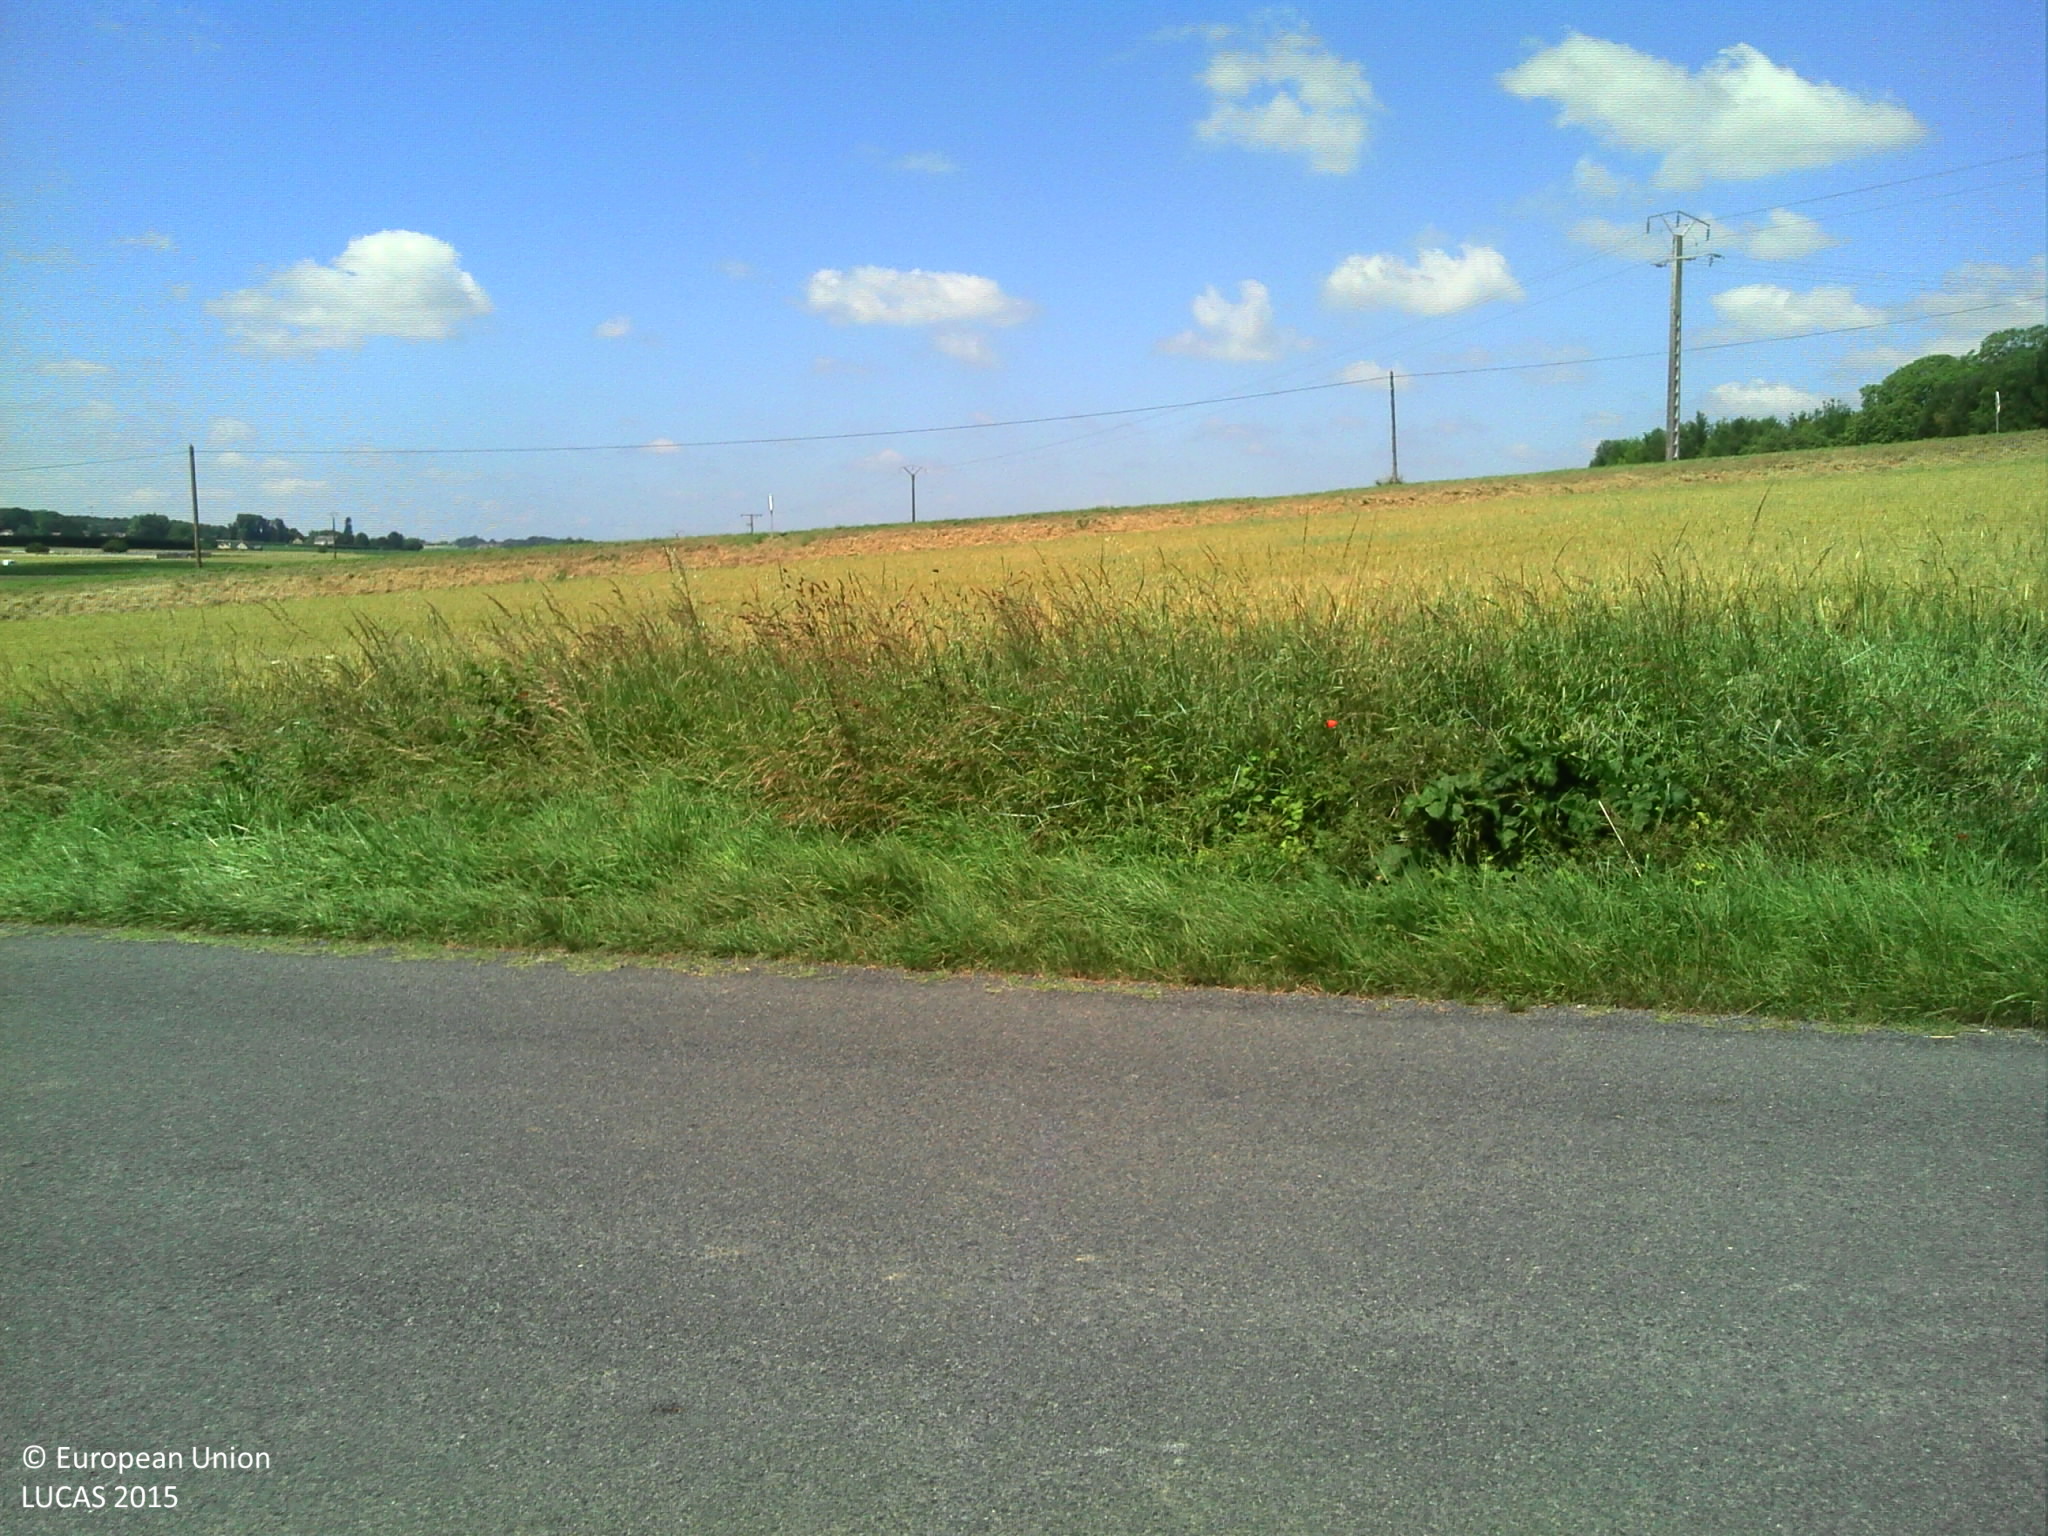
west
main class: Woodland
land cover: Broadleaved woodland
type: exotic forest
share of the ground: 25 - 50 %
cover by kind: herbaceous plants 65 %, broadleaved forest trees 25 %, unconsolidated bare surface 10 %
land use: Forestry
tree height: < 5 m
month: June
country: FR
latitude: 46.9457
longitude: 0.5349
